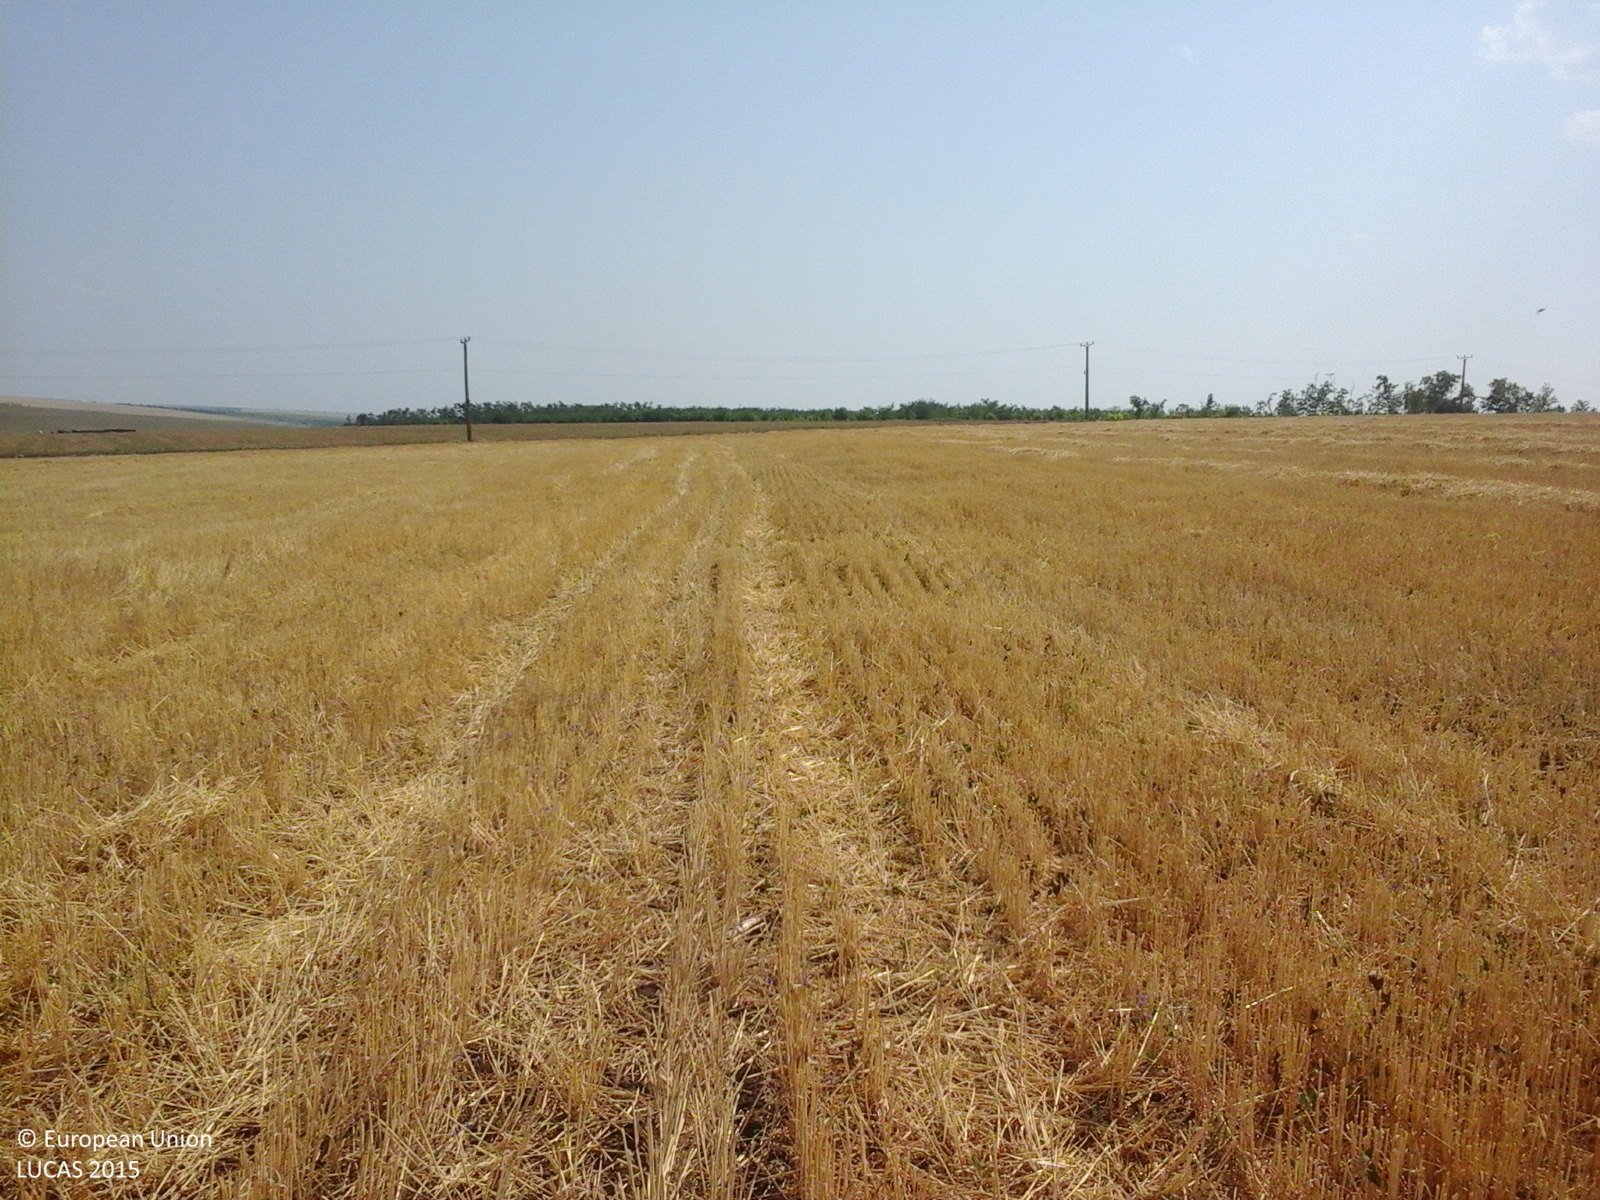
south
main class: Cropland
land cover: Common wheat
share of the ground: > 75 %
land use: Agriculture (excluding fallow land and kitchen gardens)
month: July
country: RO
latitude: 45.7610
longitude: 27.9249
